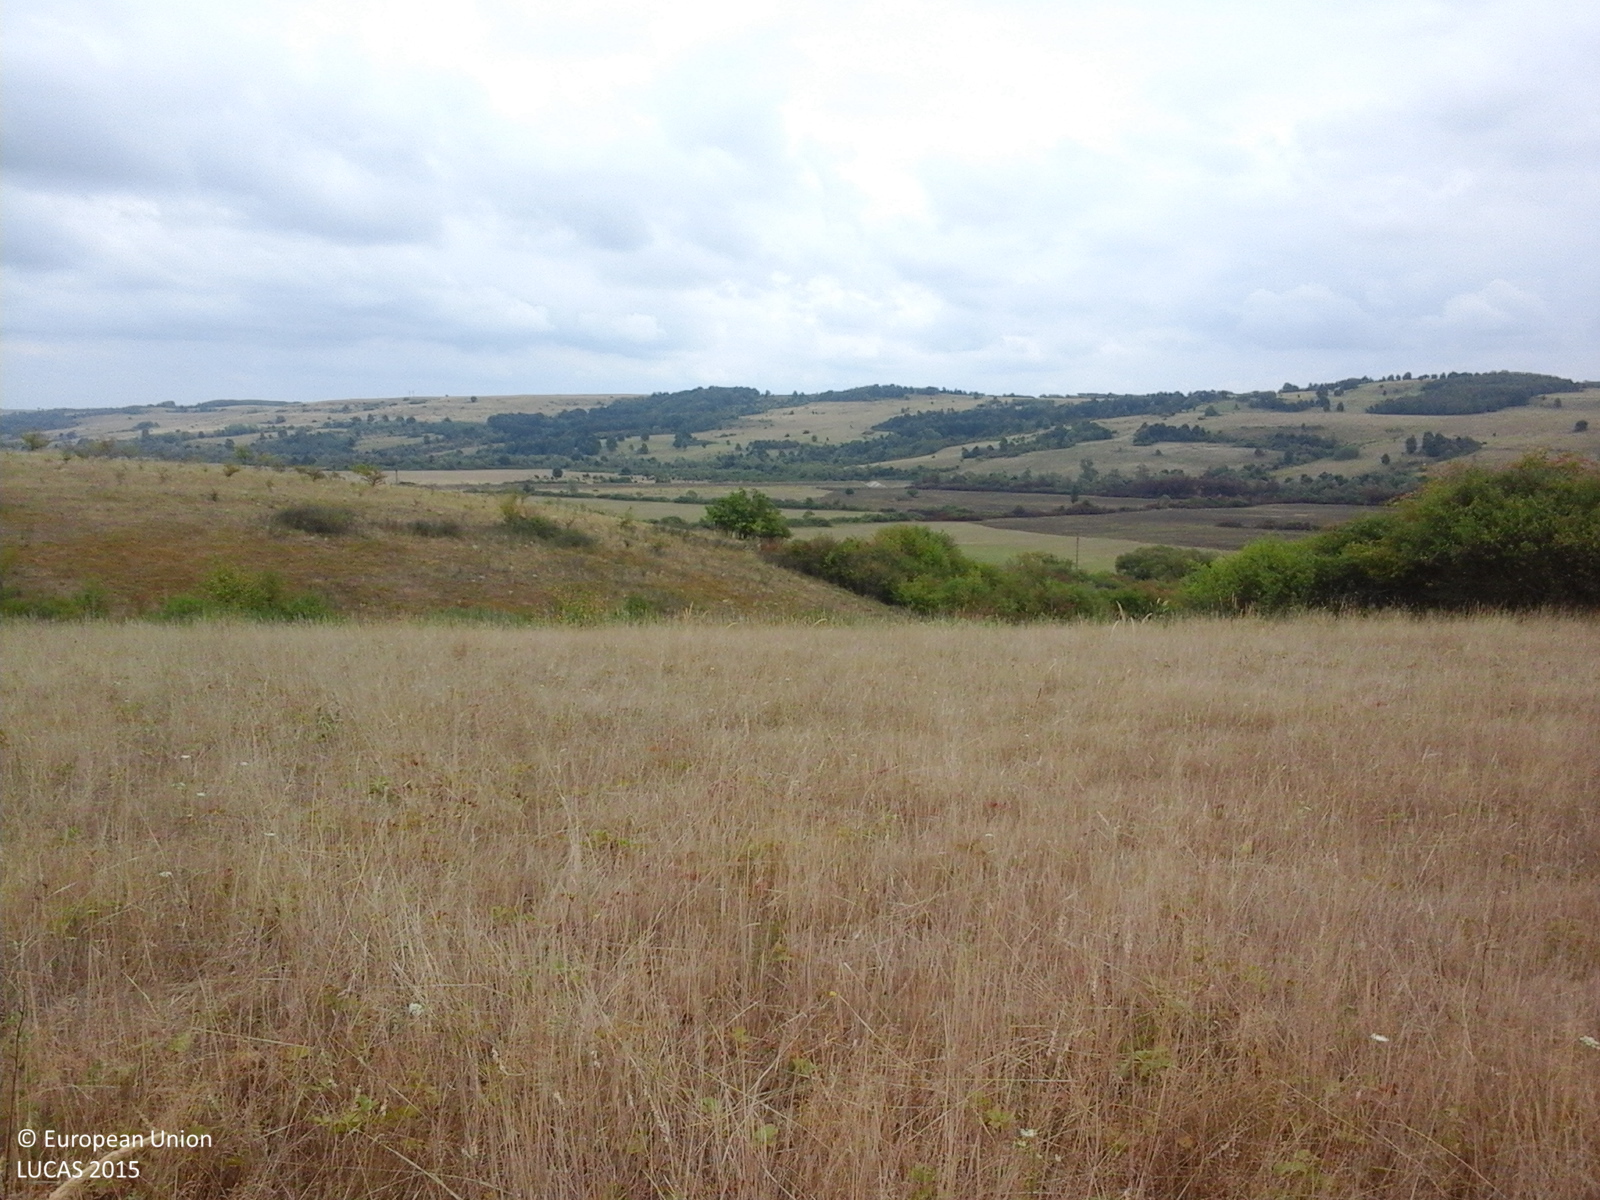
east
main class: Grassland
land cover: Grassland without tree/shrub cover
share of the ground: > 75 %
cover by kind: herbaceous plants 100 %
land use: Agriculture (excluding fallow land and kitchen gardens)
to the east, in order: Grassland without tree/shrub cover; Shrubland without tree cover; Grassland with sparse tree/shrub cover; Grassland without tree/shrub cover; Electric lines; Grassland without tree/shrub cover
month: August
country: RO
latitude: 45.8922
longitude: 21.8307
